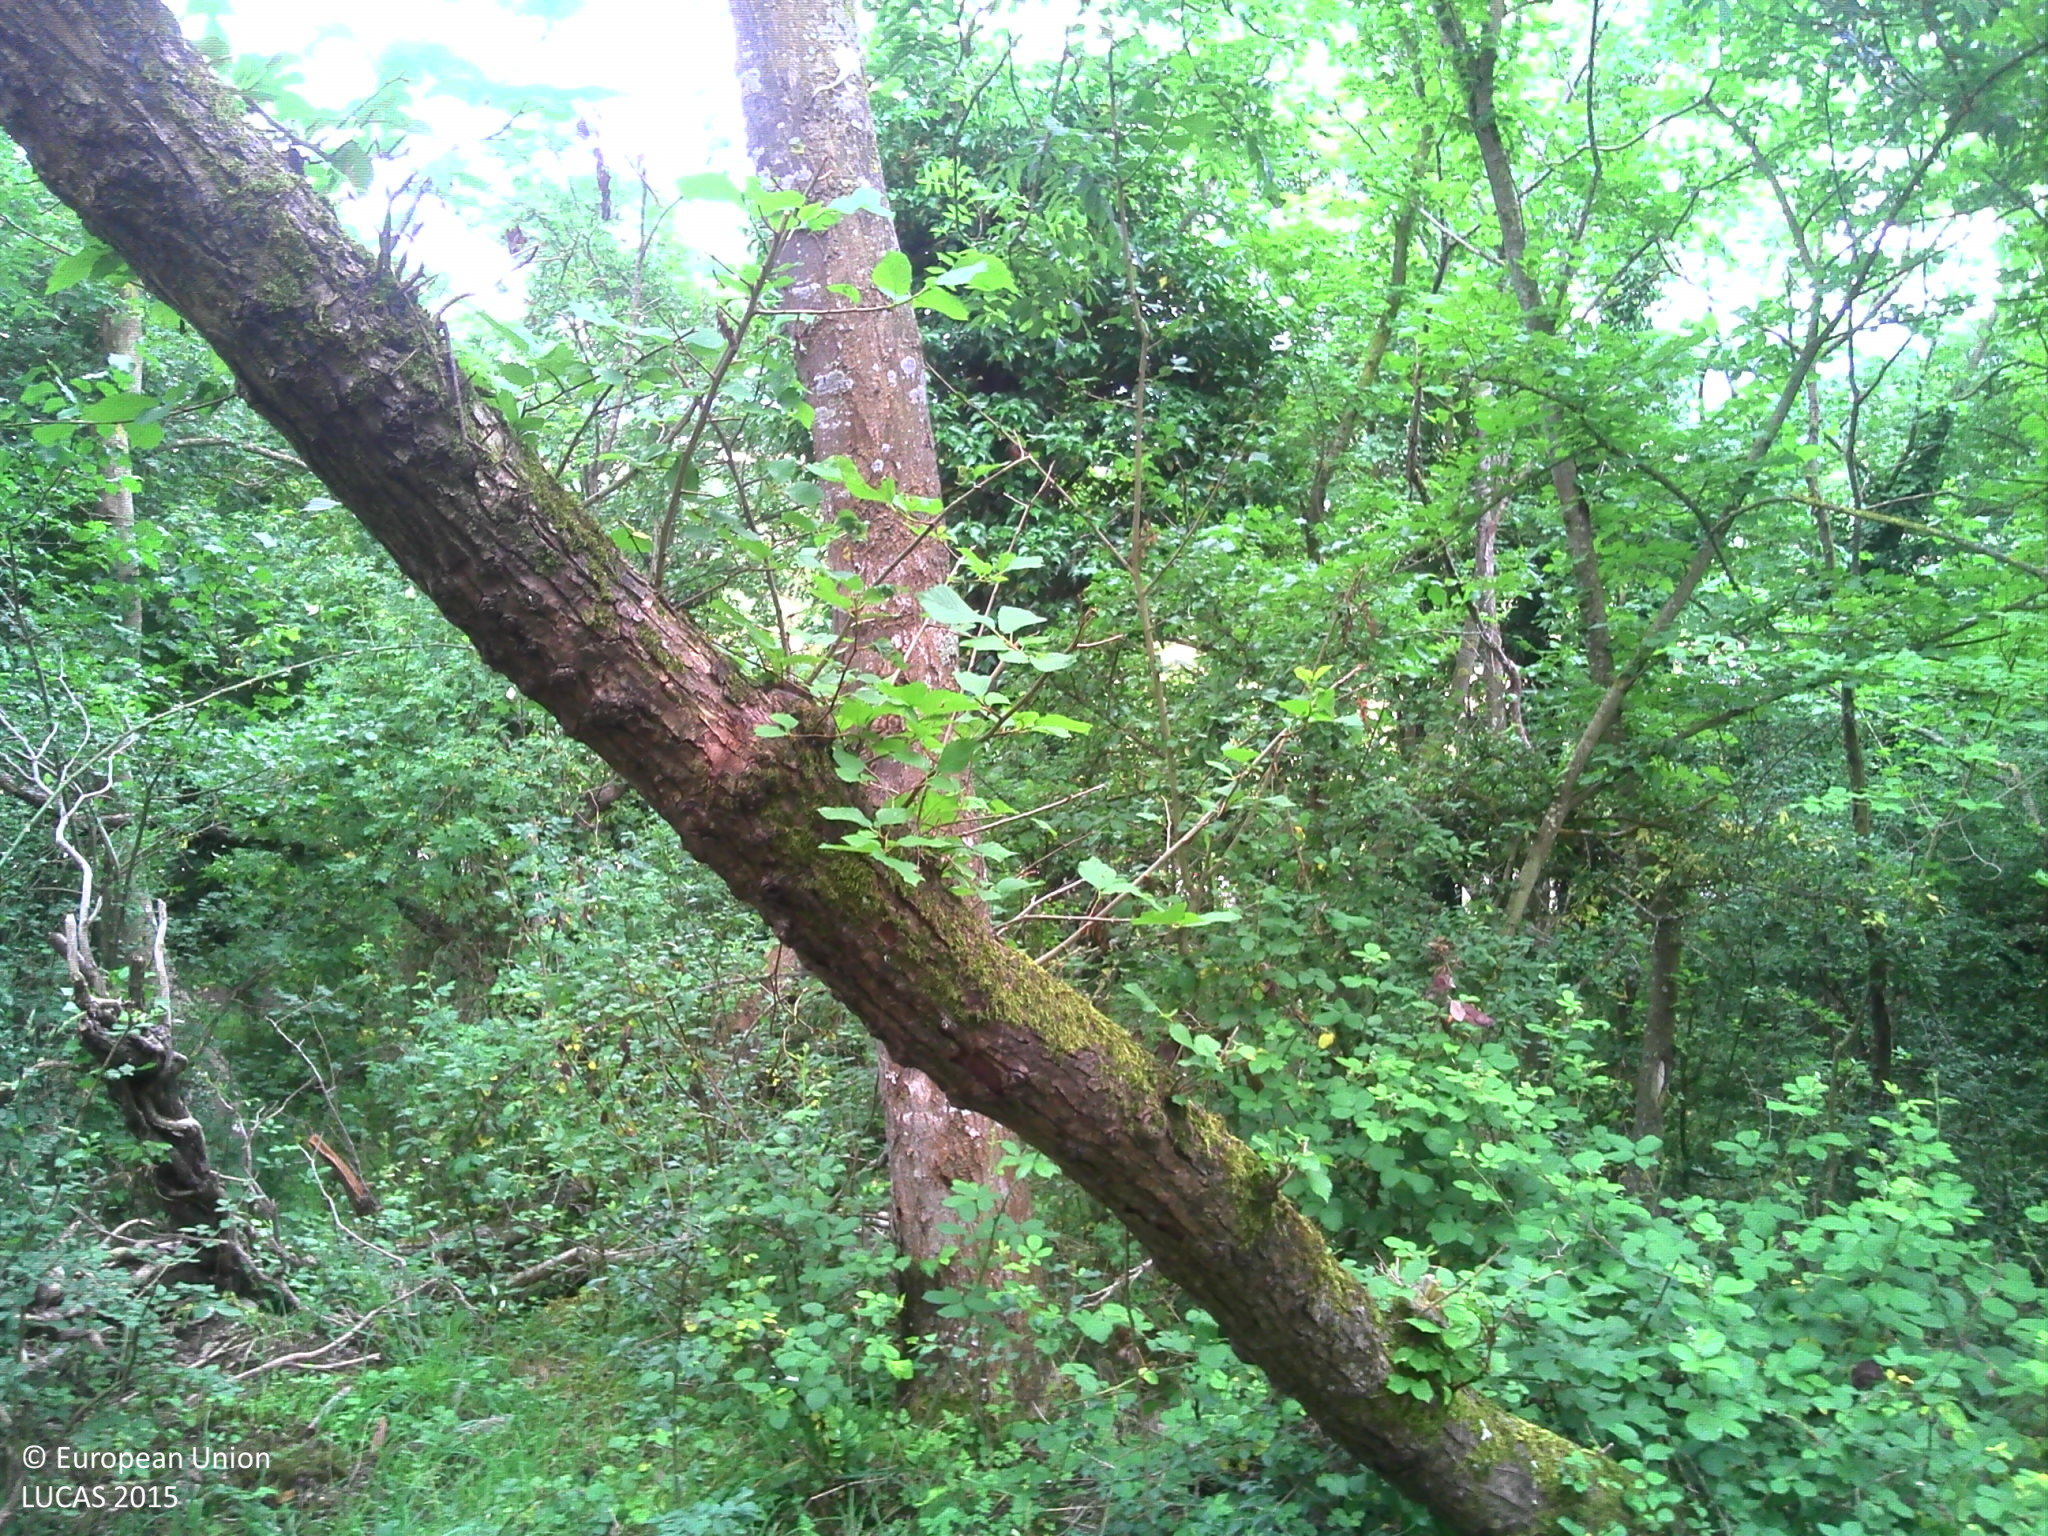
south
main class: Woodland
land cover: Broadleaved woodland
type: mesophytic deciduous forest
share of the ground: > 75 %
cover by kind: broadleaved forest trees 90 %, lichens and mosses 10 %
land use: Forestry
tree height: > 5 m
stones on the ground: 10 - 25 %
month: June
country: FR
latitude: 48.8051
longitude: 0.0443
